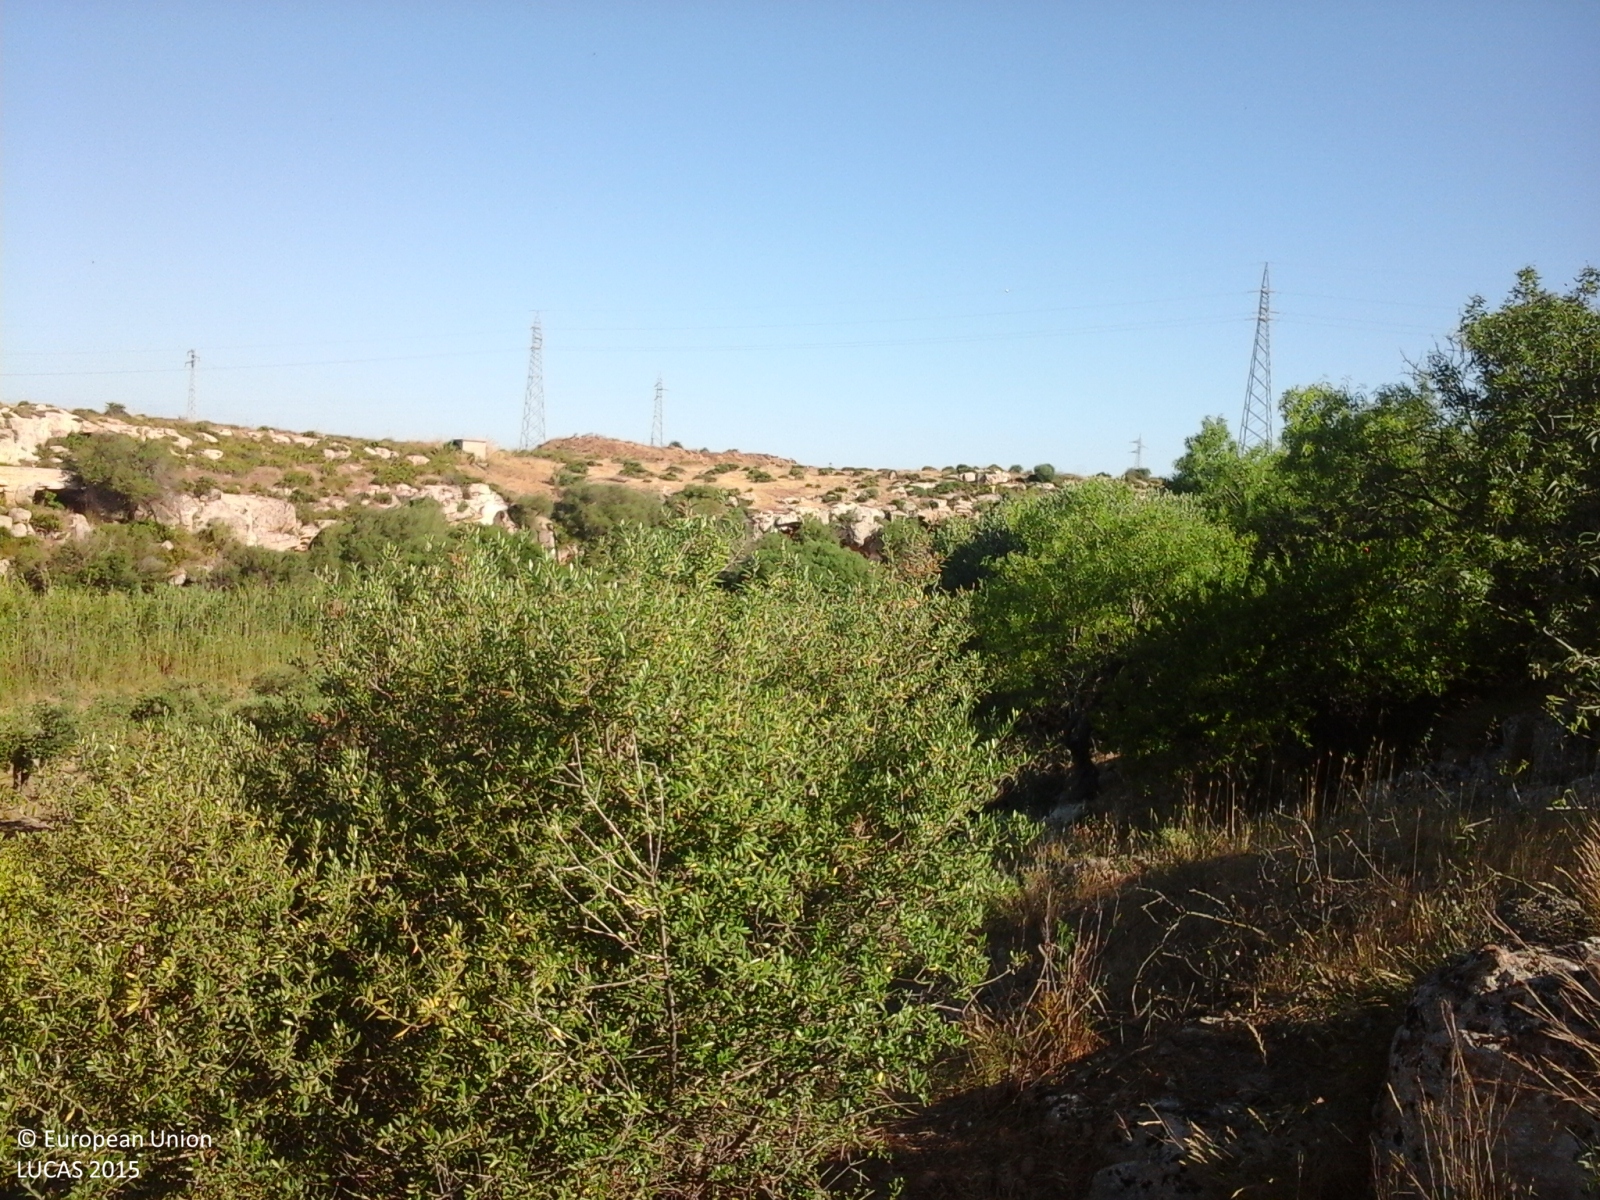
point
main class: Grassland
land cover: Grassland with sparse tree/shrub cover
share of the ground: > 75 %
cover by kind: herbaceous plants 85 %, shrubs 10 %, broadleaved forest trees 5 %
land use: Forestry
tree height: < 5 m
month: June
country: IT
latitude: 37.6939
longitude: 12.6000
